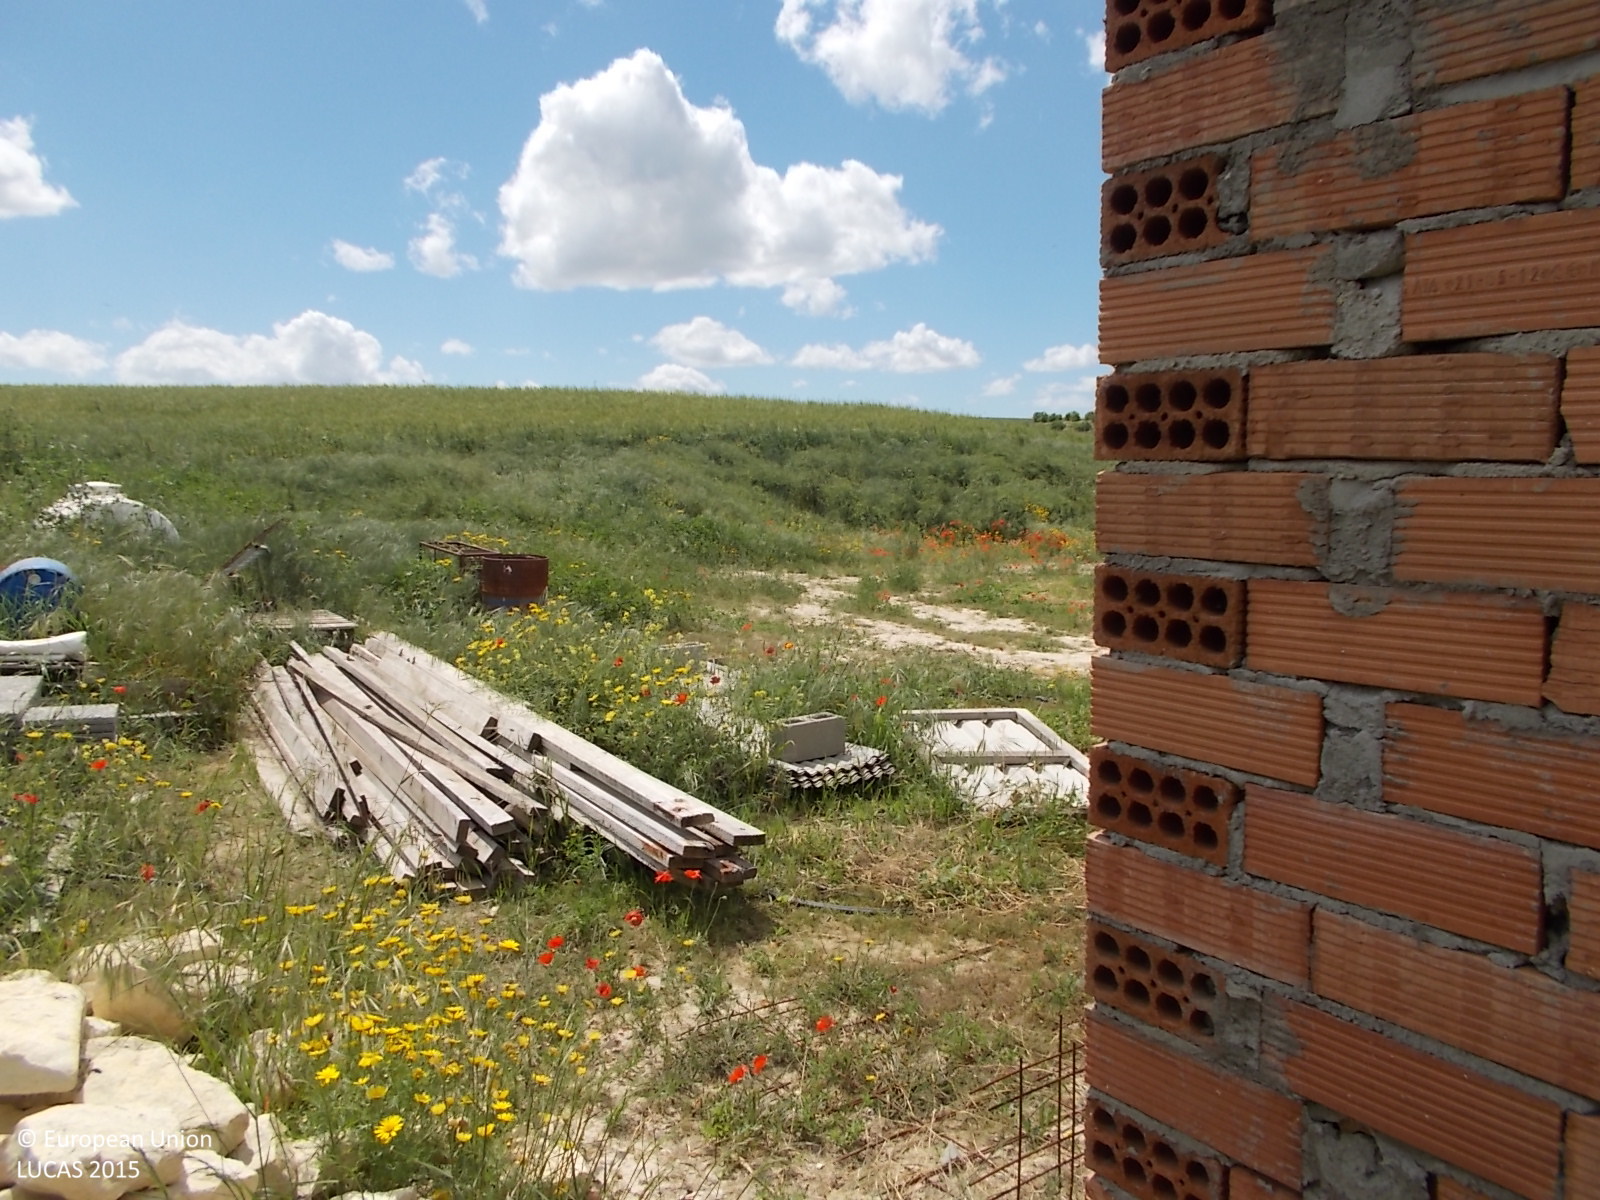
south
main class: Grassland
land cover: Grassland with sparse tree/shrub cover
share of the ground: > 75 %
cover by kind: herbaceous plants 80 %, unconsolidated bare surface 15 %, broadleaved forest trees 5 %
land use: Abandoned areas
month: April
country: CY
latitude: 35.0317
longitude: 33.5323
